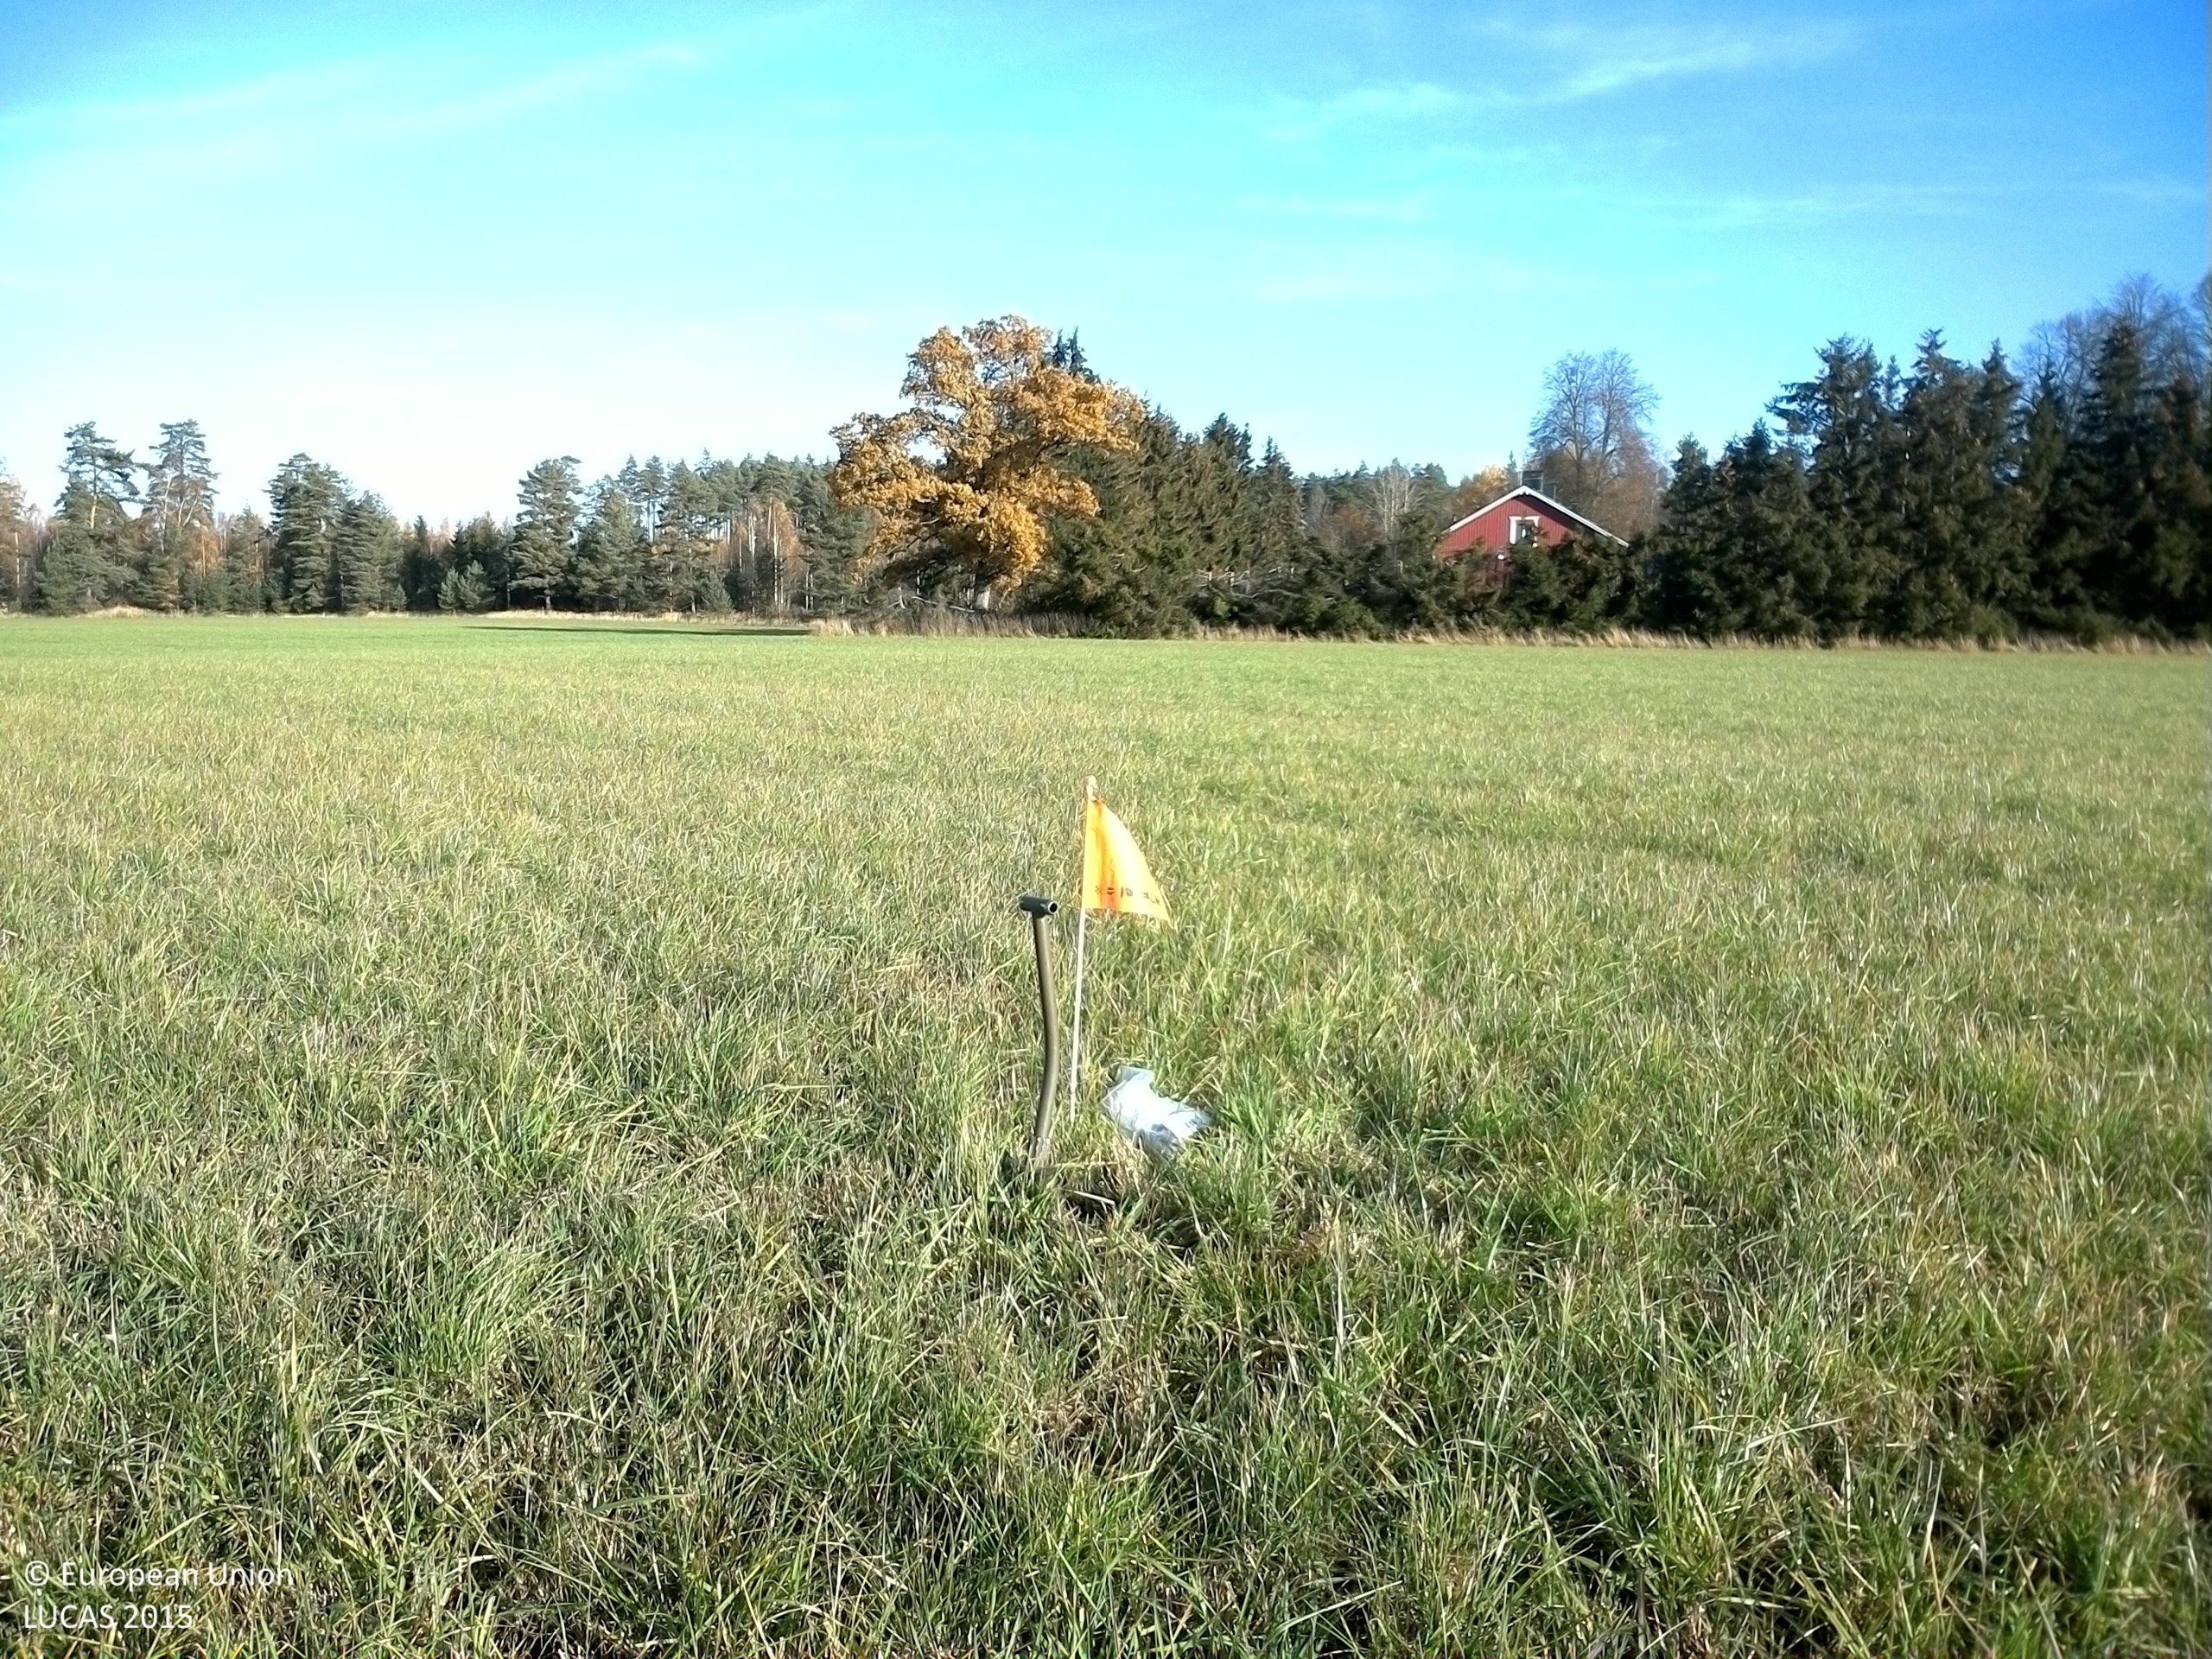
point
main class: Cropland
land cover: Temporary grasslands
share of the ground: > 75 %
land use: Agriculture (excluding fallow land and kitchen gardens)
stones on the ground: < 10 %
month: October
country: SE
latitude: 59.8124
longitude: 16.5347
